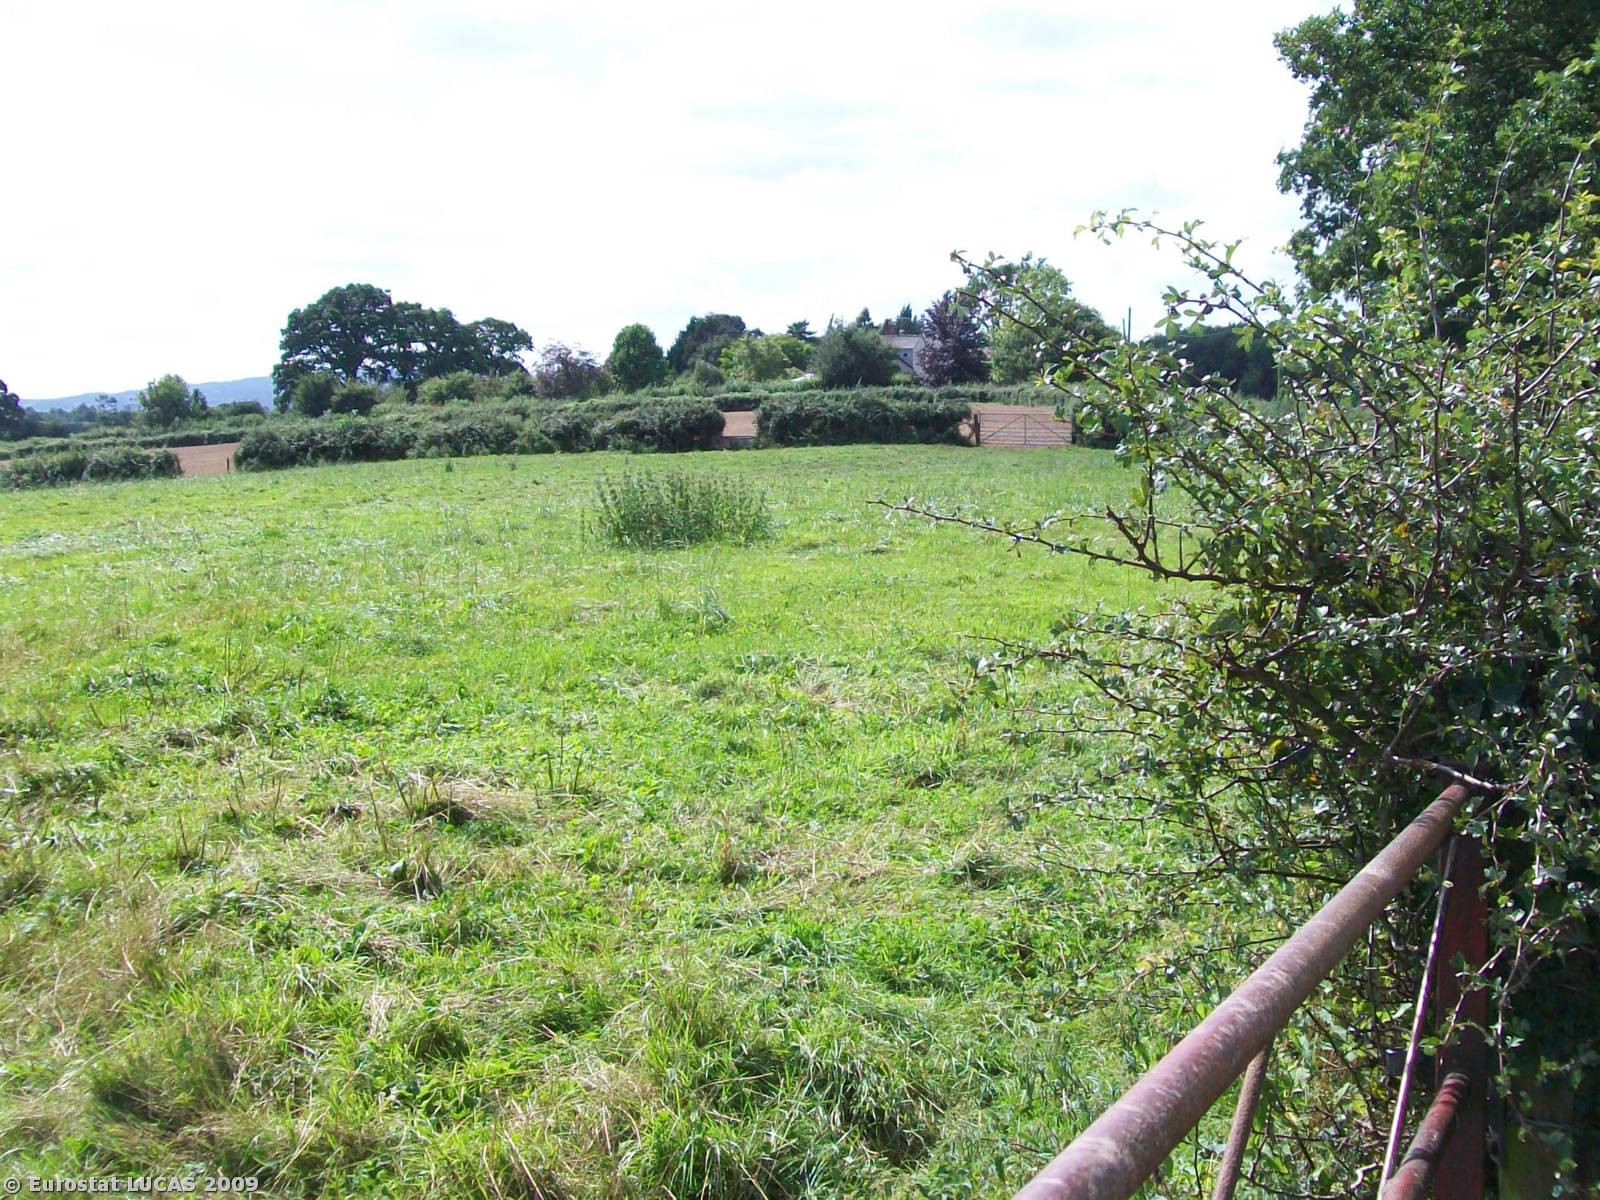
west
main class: Grassland
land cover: Grassland without tree/shrub cover
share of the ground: > 75 %
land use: Agriculture (excluding fallow land and kitchen gardens)
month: August
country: GB
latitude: 51.8526
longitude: -2.3905
